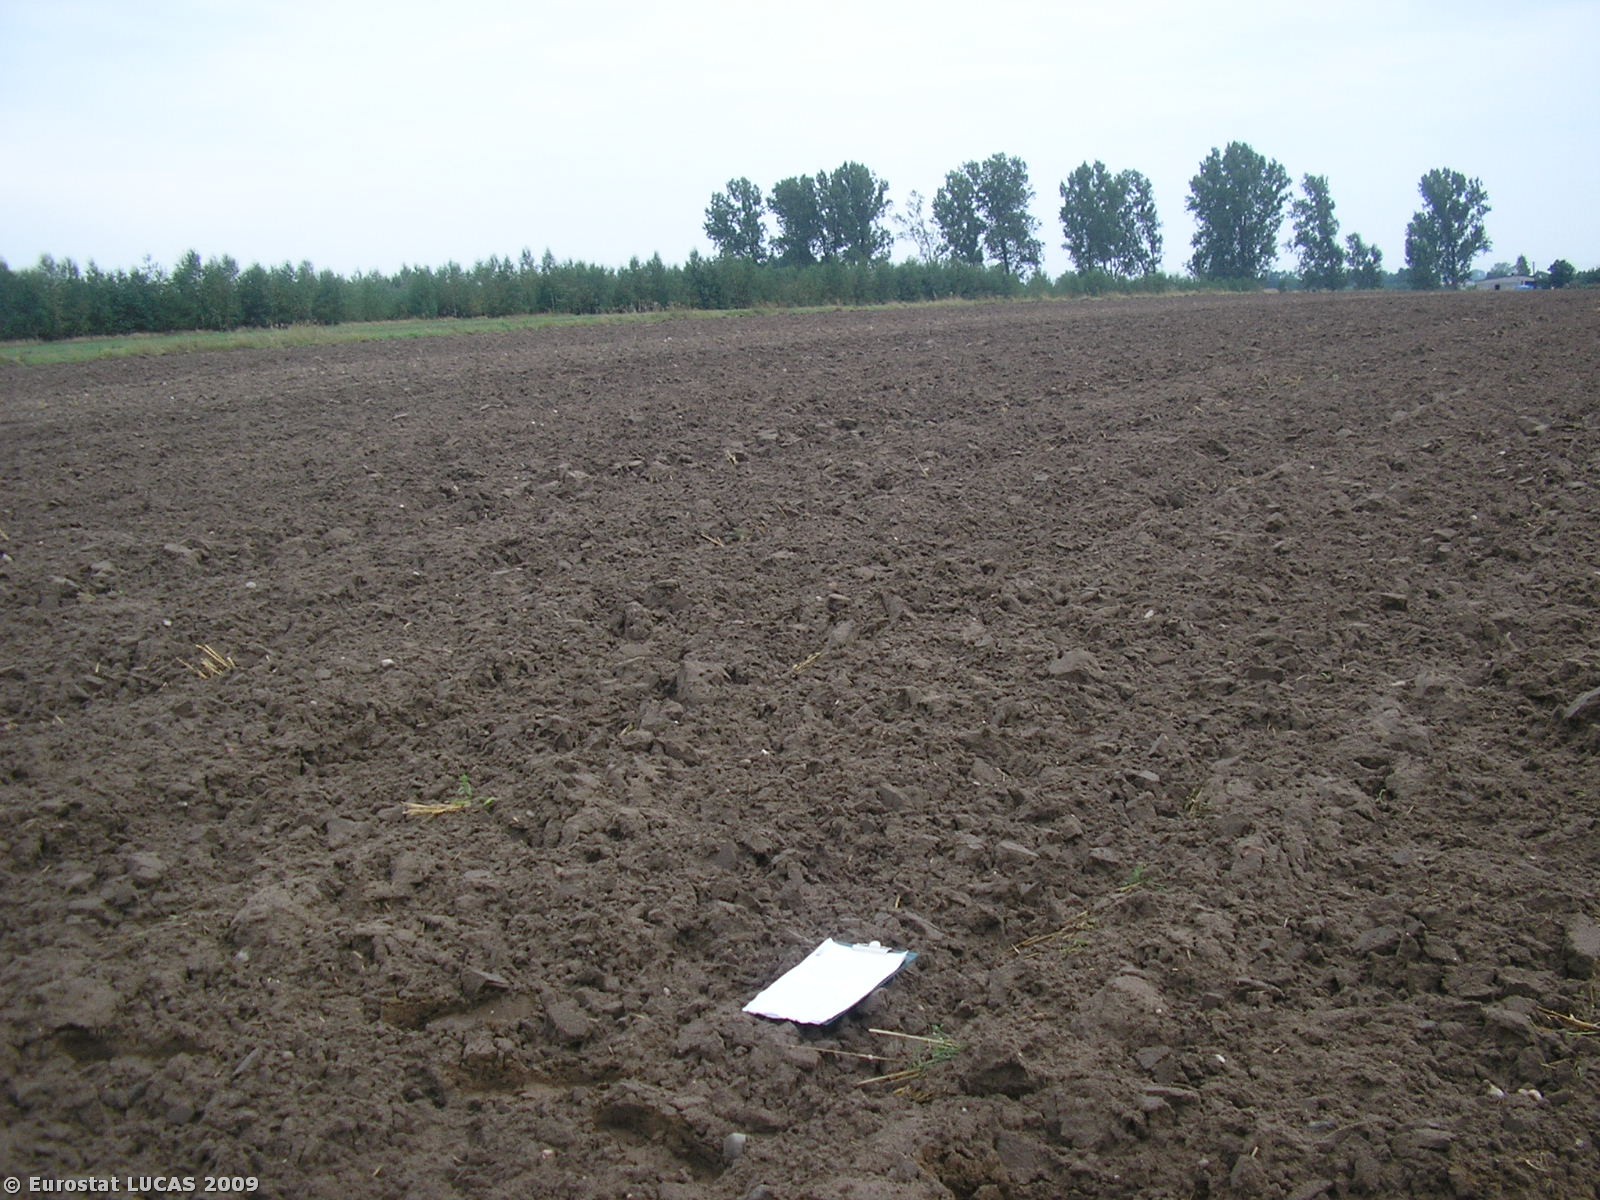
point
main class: Cropland
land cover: Barley
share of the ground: < 10 %
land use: Agriculture (excluding fallow land and kitchen gardens)
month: August
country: PL
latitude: 52.2928
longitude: 19.6324
